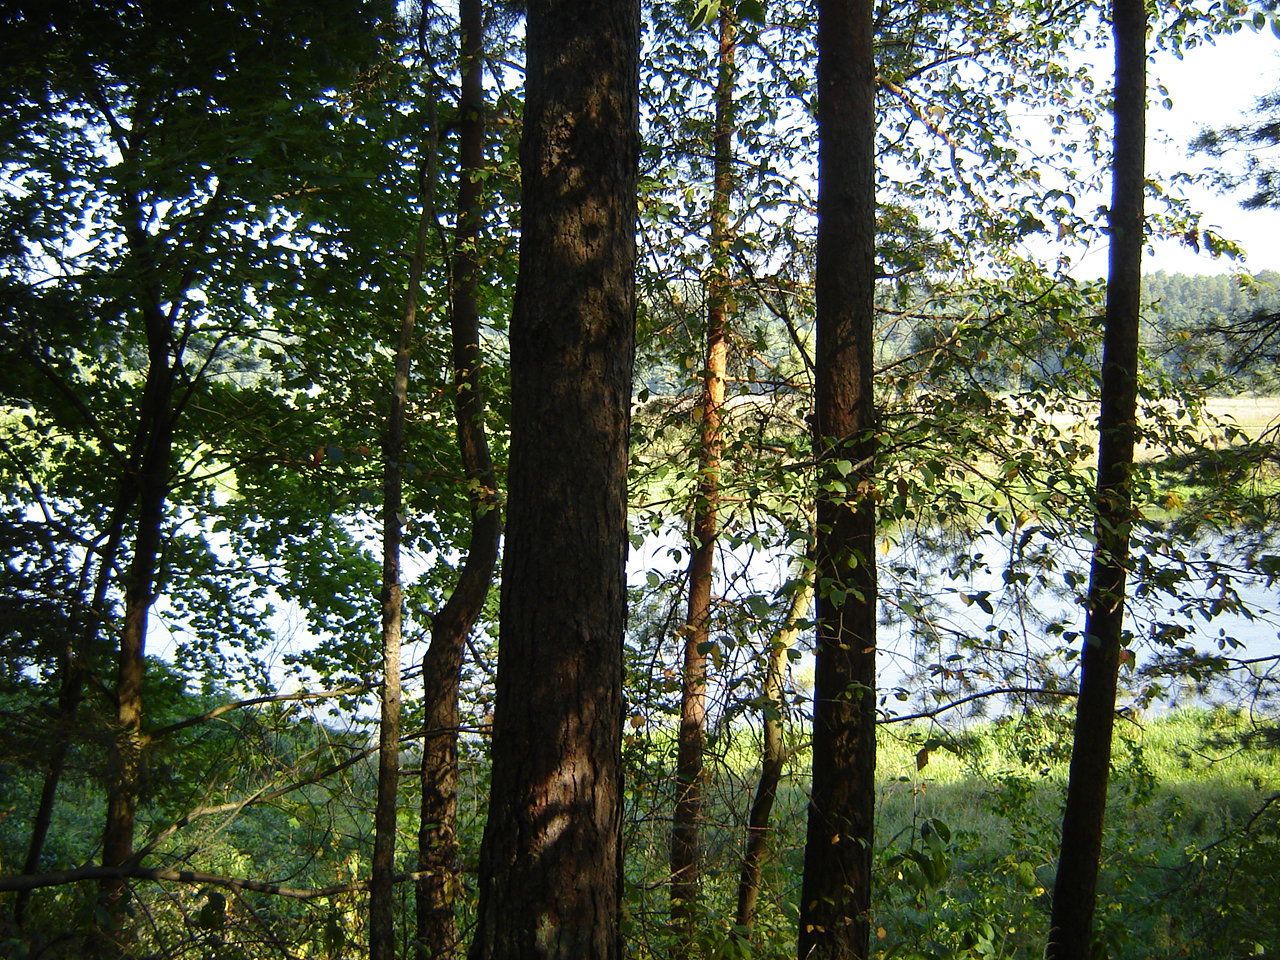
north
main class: Woodland
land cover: Pine dominated coniferous woodland
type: hemiboreal forest and nemoral coniferous forest and mixed broadleaved-coniferous forest
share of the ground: > 75 %
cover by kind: coniferous forest trees 80 %, broadleaved forest trees 5 %, shrubs 5 %, herbaceous plants 5 %, lichens and mosses 5 %
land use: Forestry
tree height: > 5 m
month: August
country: LT
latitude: 54.8785
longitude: 24.8386
